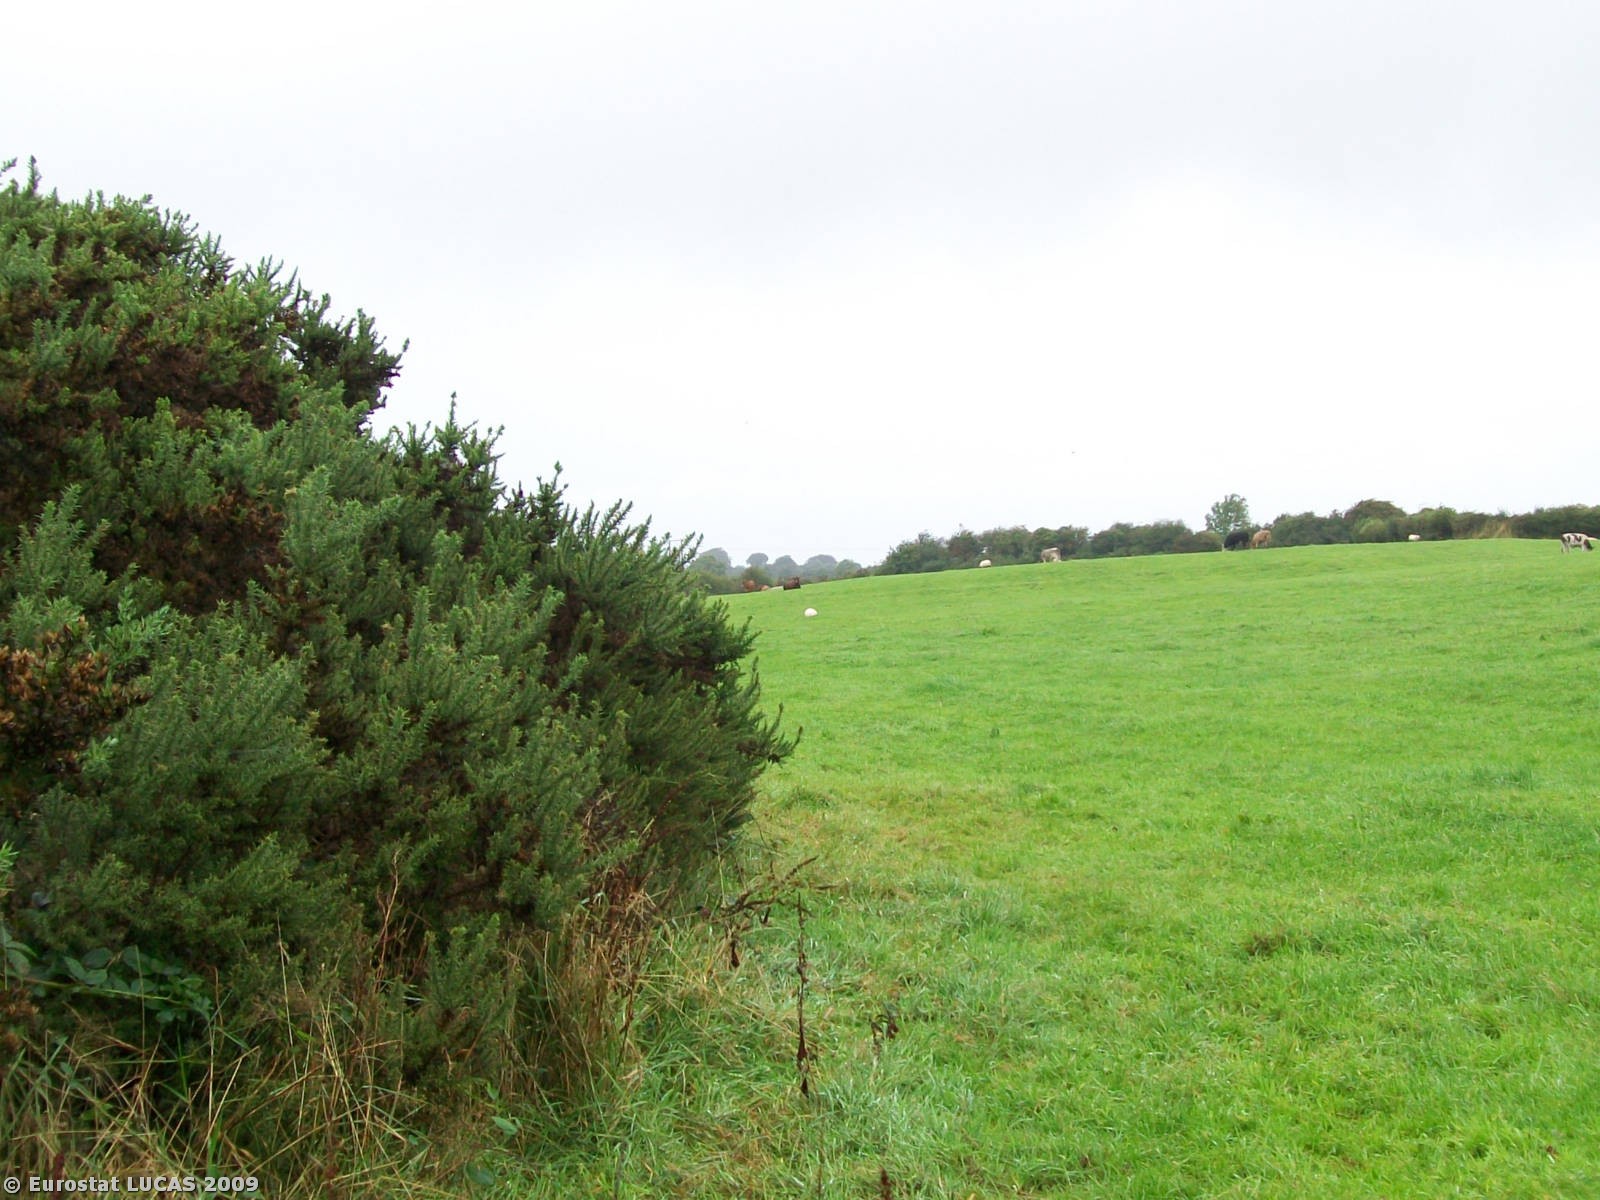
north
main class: Shrubland
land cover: Shrubland without tree cover
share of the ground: > 75 %
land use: Fallow land
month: September
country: IE
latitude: 53.1942
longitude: -7.9093
